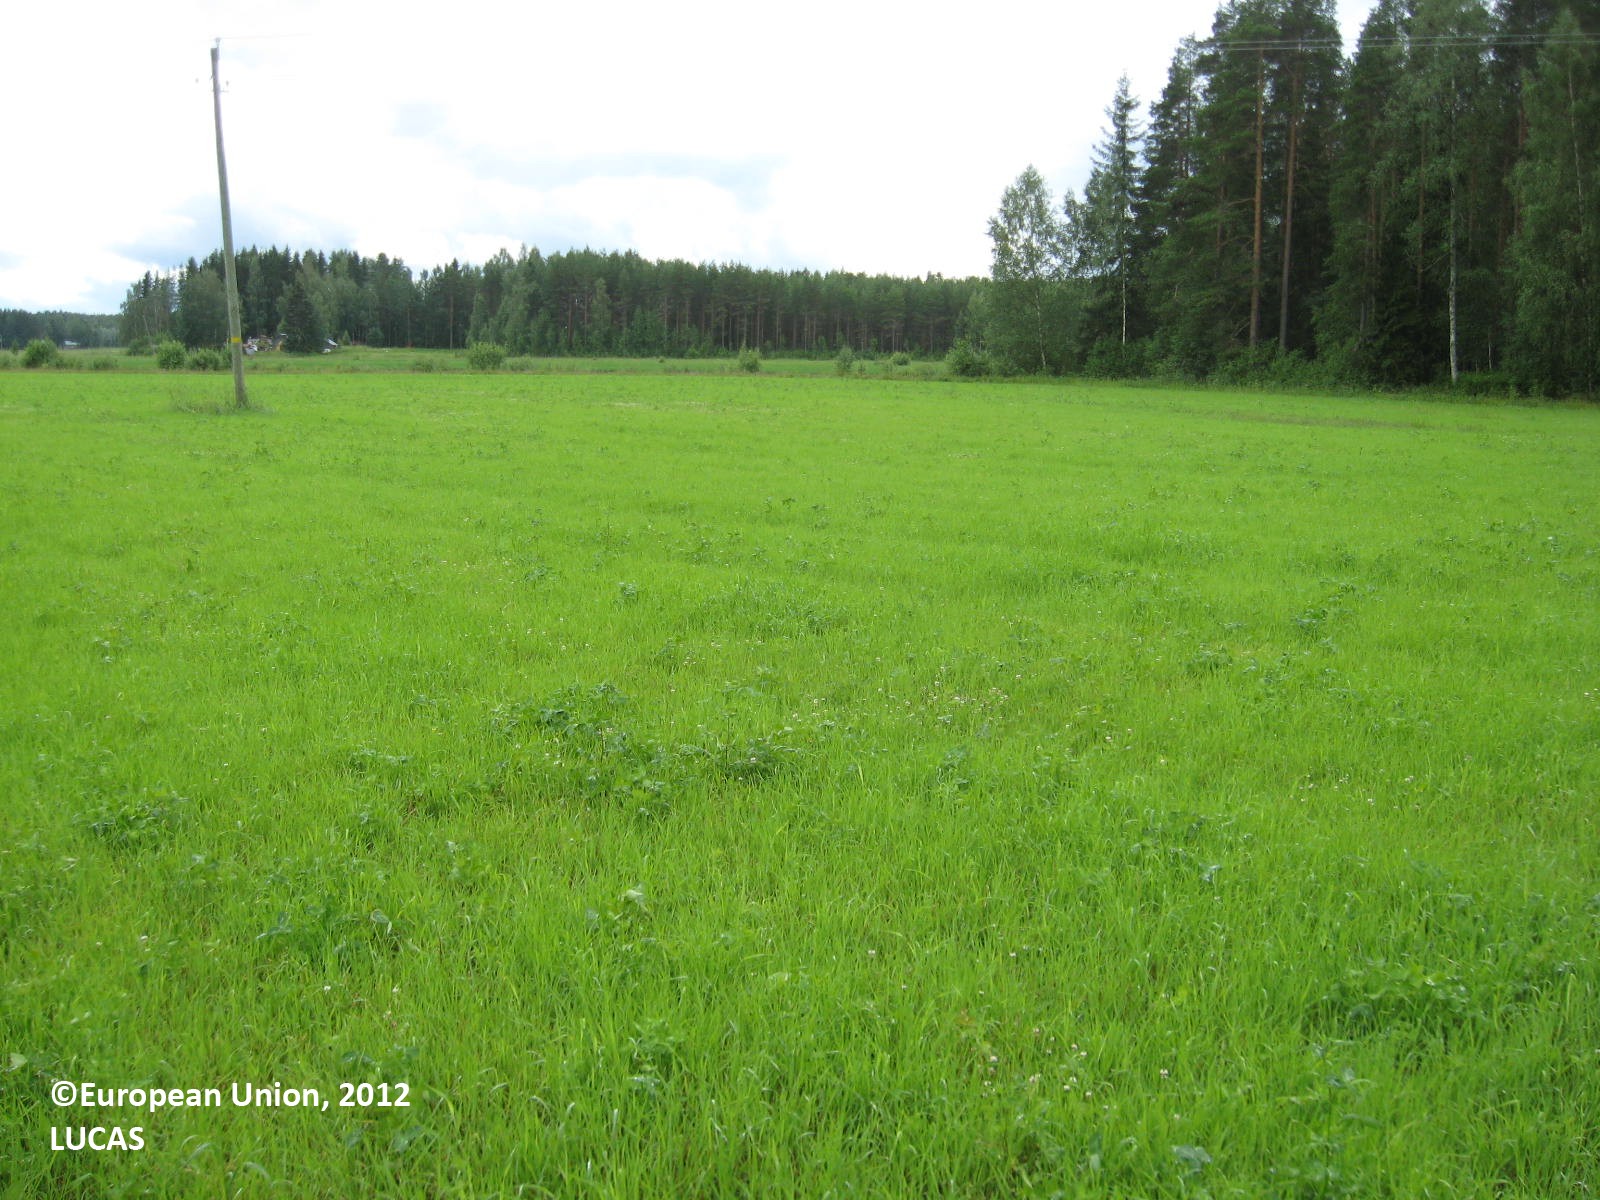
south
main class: Cropland
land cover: Temporary grasslands
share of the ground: > 75 %
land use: Agriculture (excluding fallow land and kitchen gardens)
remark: Harvested field
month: July
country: FI
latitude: 62.3183
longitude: 22.8159
